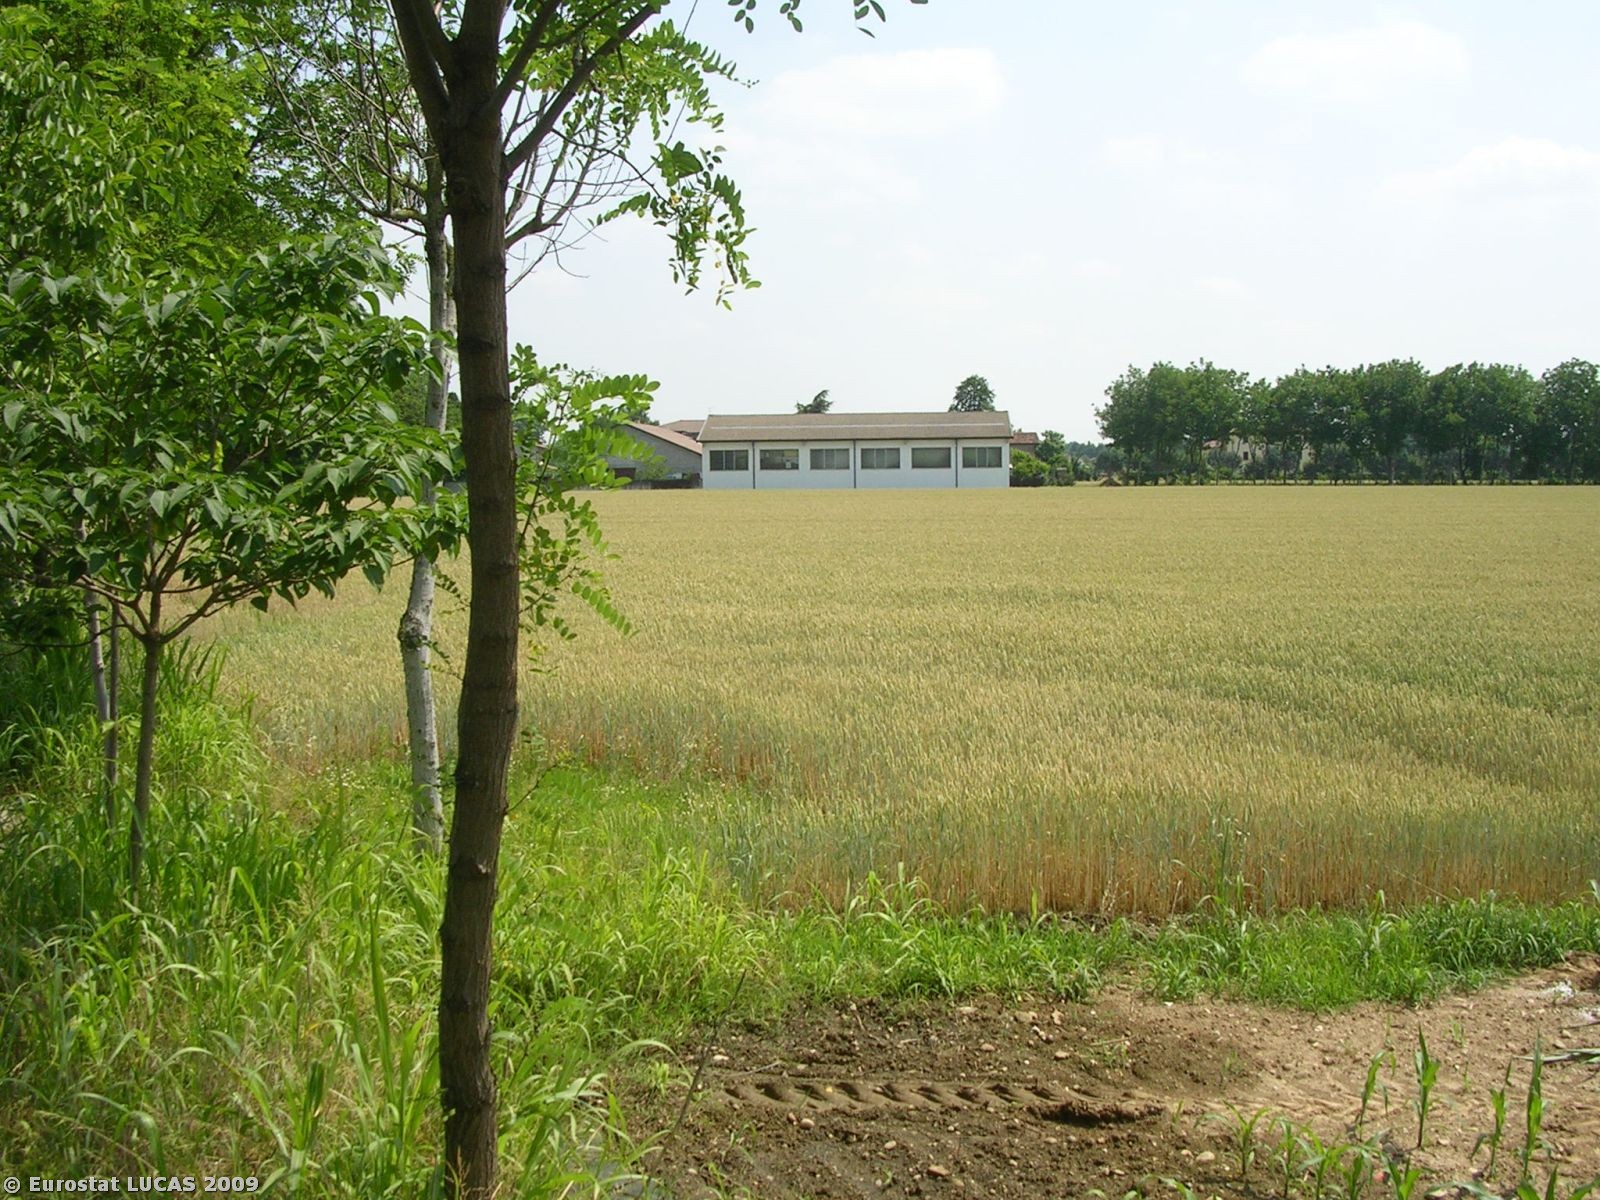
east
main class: Cropland
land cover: Maize
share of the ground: 50 - 75 %
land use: Agriculture (excluding fallow land and kitchen gardens)
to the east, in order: Maize; Common wheat; Maize; Lines of trees; Ditches and canals; Lines of trees; Common wheat
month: June
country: IT
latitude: 45.6521
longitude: 11.7553
